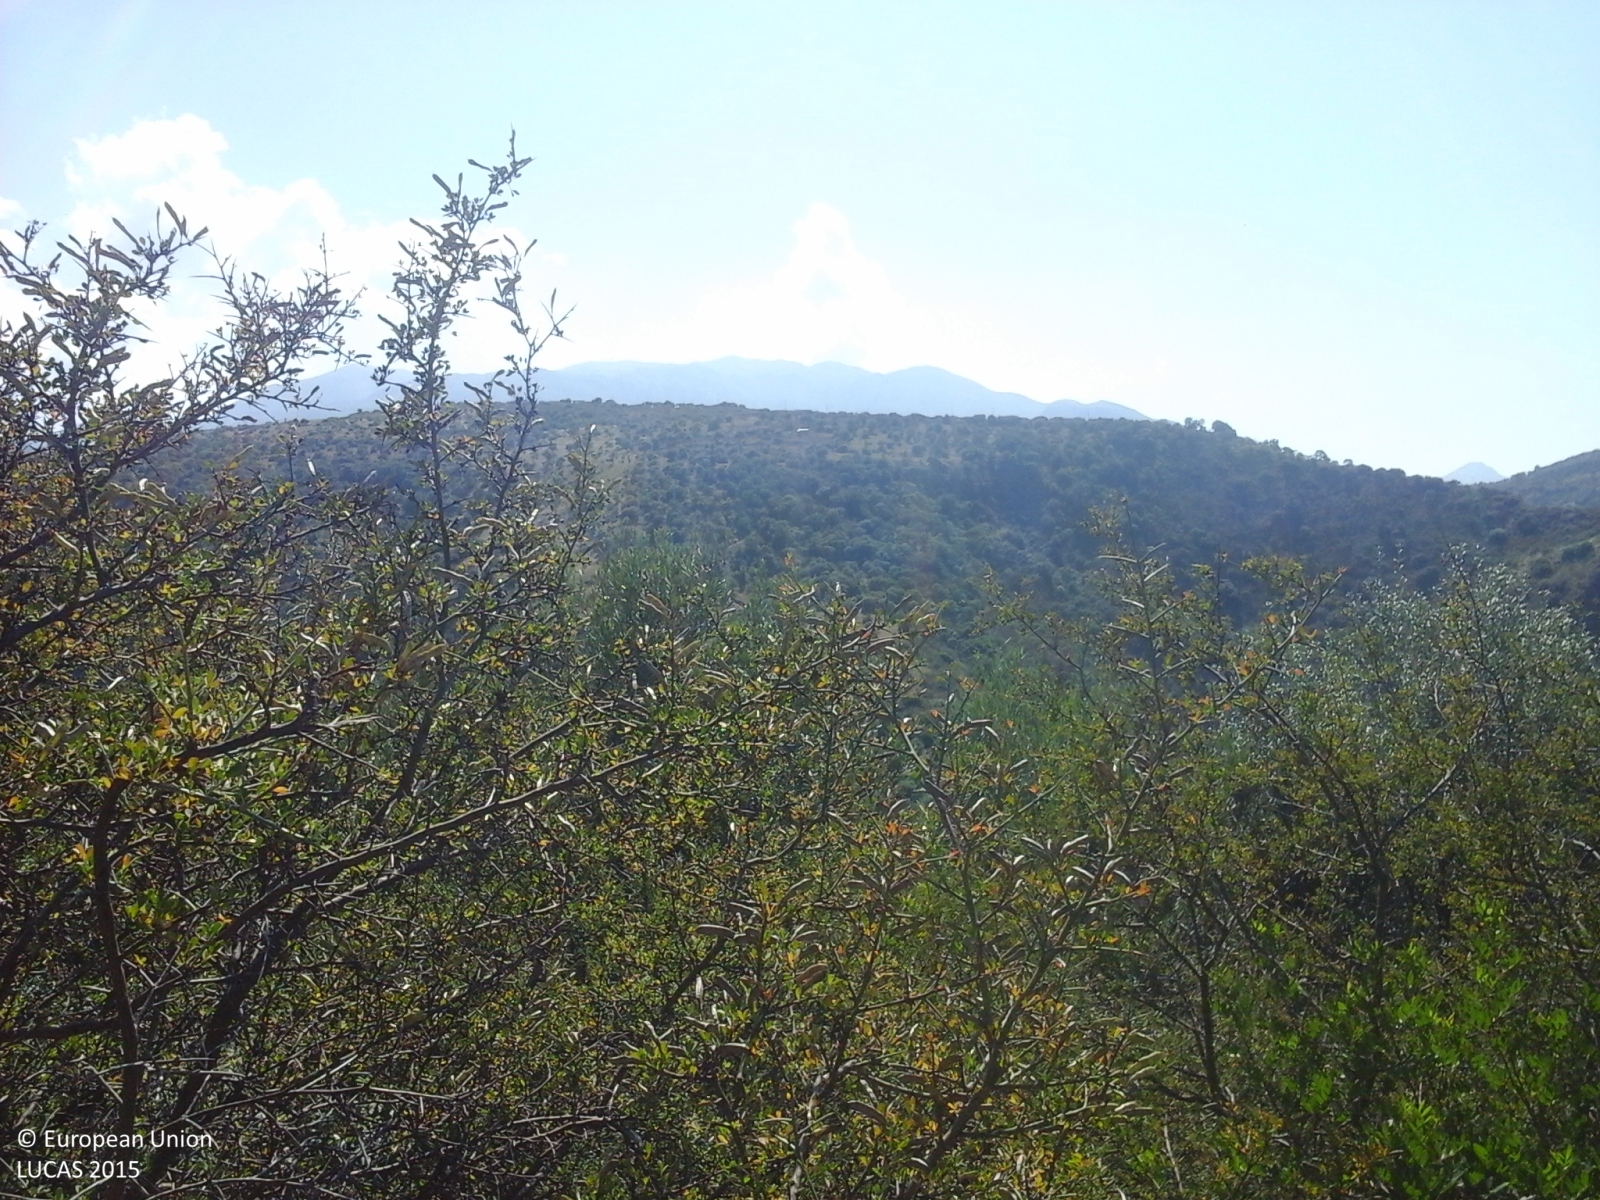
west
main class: Woodland
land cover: Broadleaved woodland
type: broadleaved evergreen forest
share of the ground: > 75 %
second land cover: Grassland without tree/shrub cover
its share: > 75 %
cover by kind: broadleaved forest trees 45 %, shrubs 40 %, herbaceous plants 15 %
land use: Forestry
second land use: Agriculture (excluding fallow land and kitchen gardens)
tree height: > 5 m
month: June
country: IT
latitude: 37.9297
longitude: 14.1464
